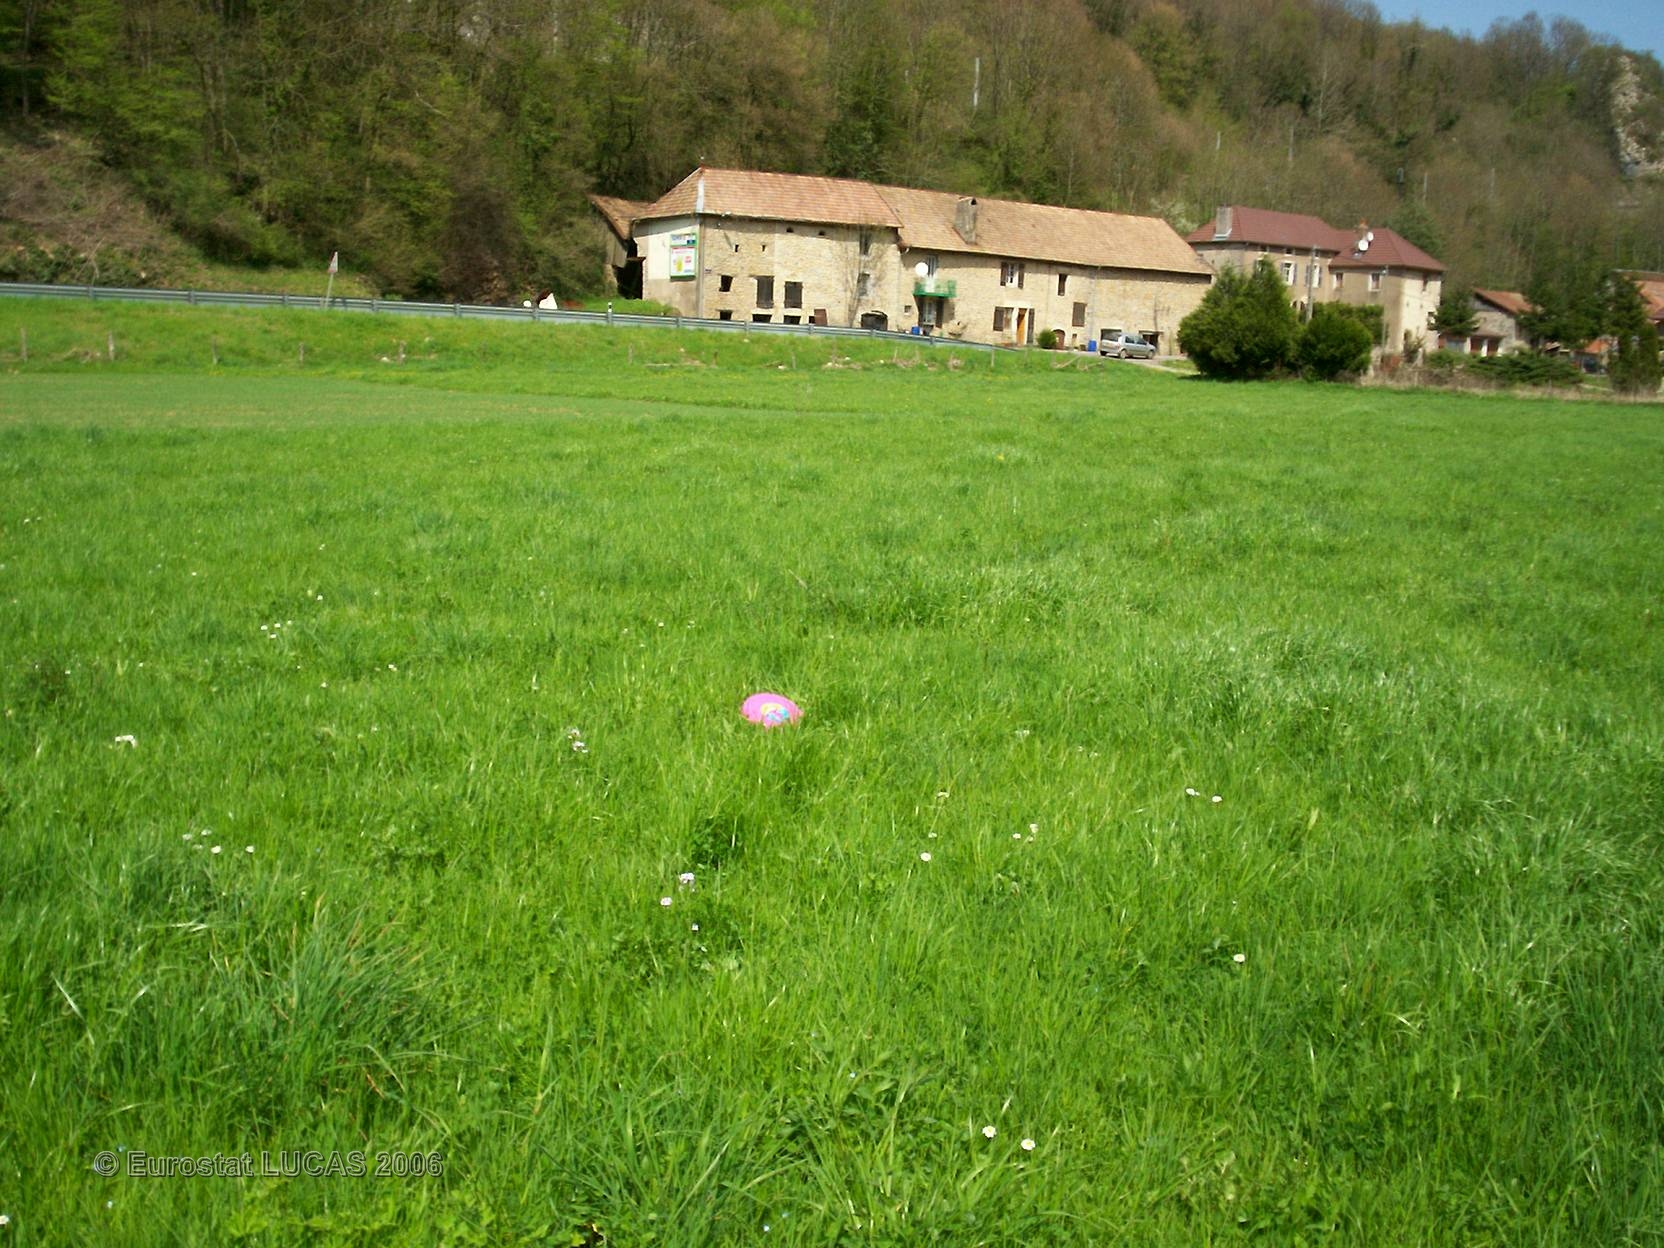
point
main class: Grassland
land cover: Grassland without tree/shrub cover
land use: Agriculture (excluding fallow land and kitchen gardens)
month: April
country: FR
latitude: 47.3537
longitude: 6.3876
